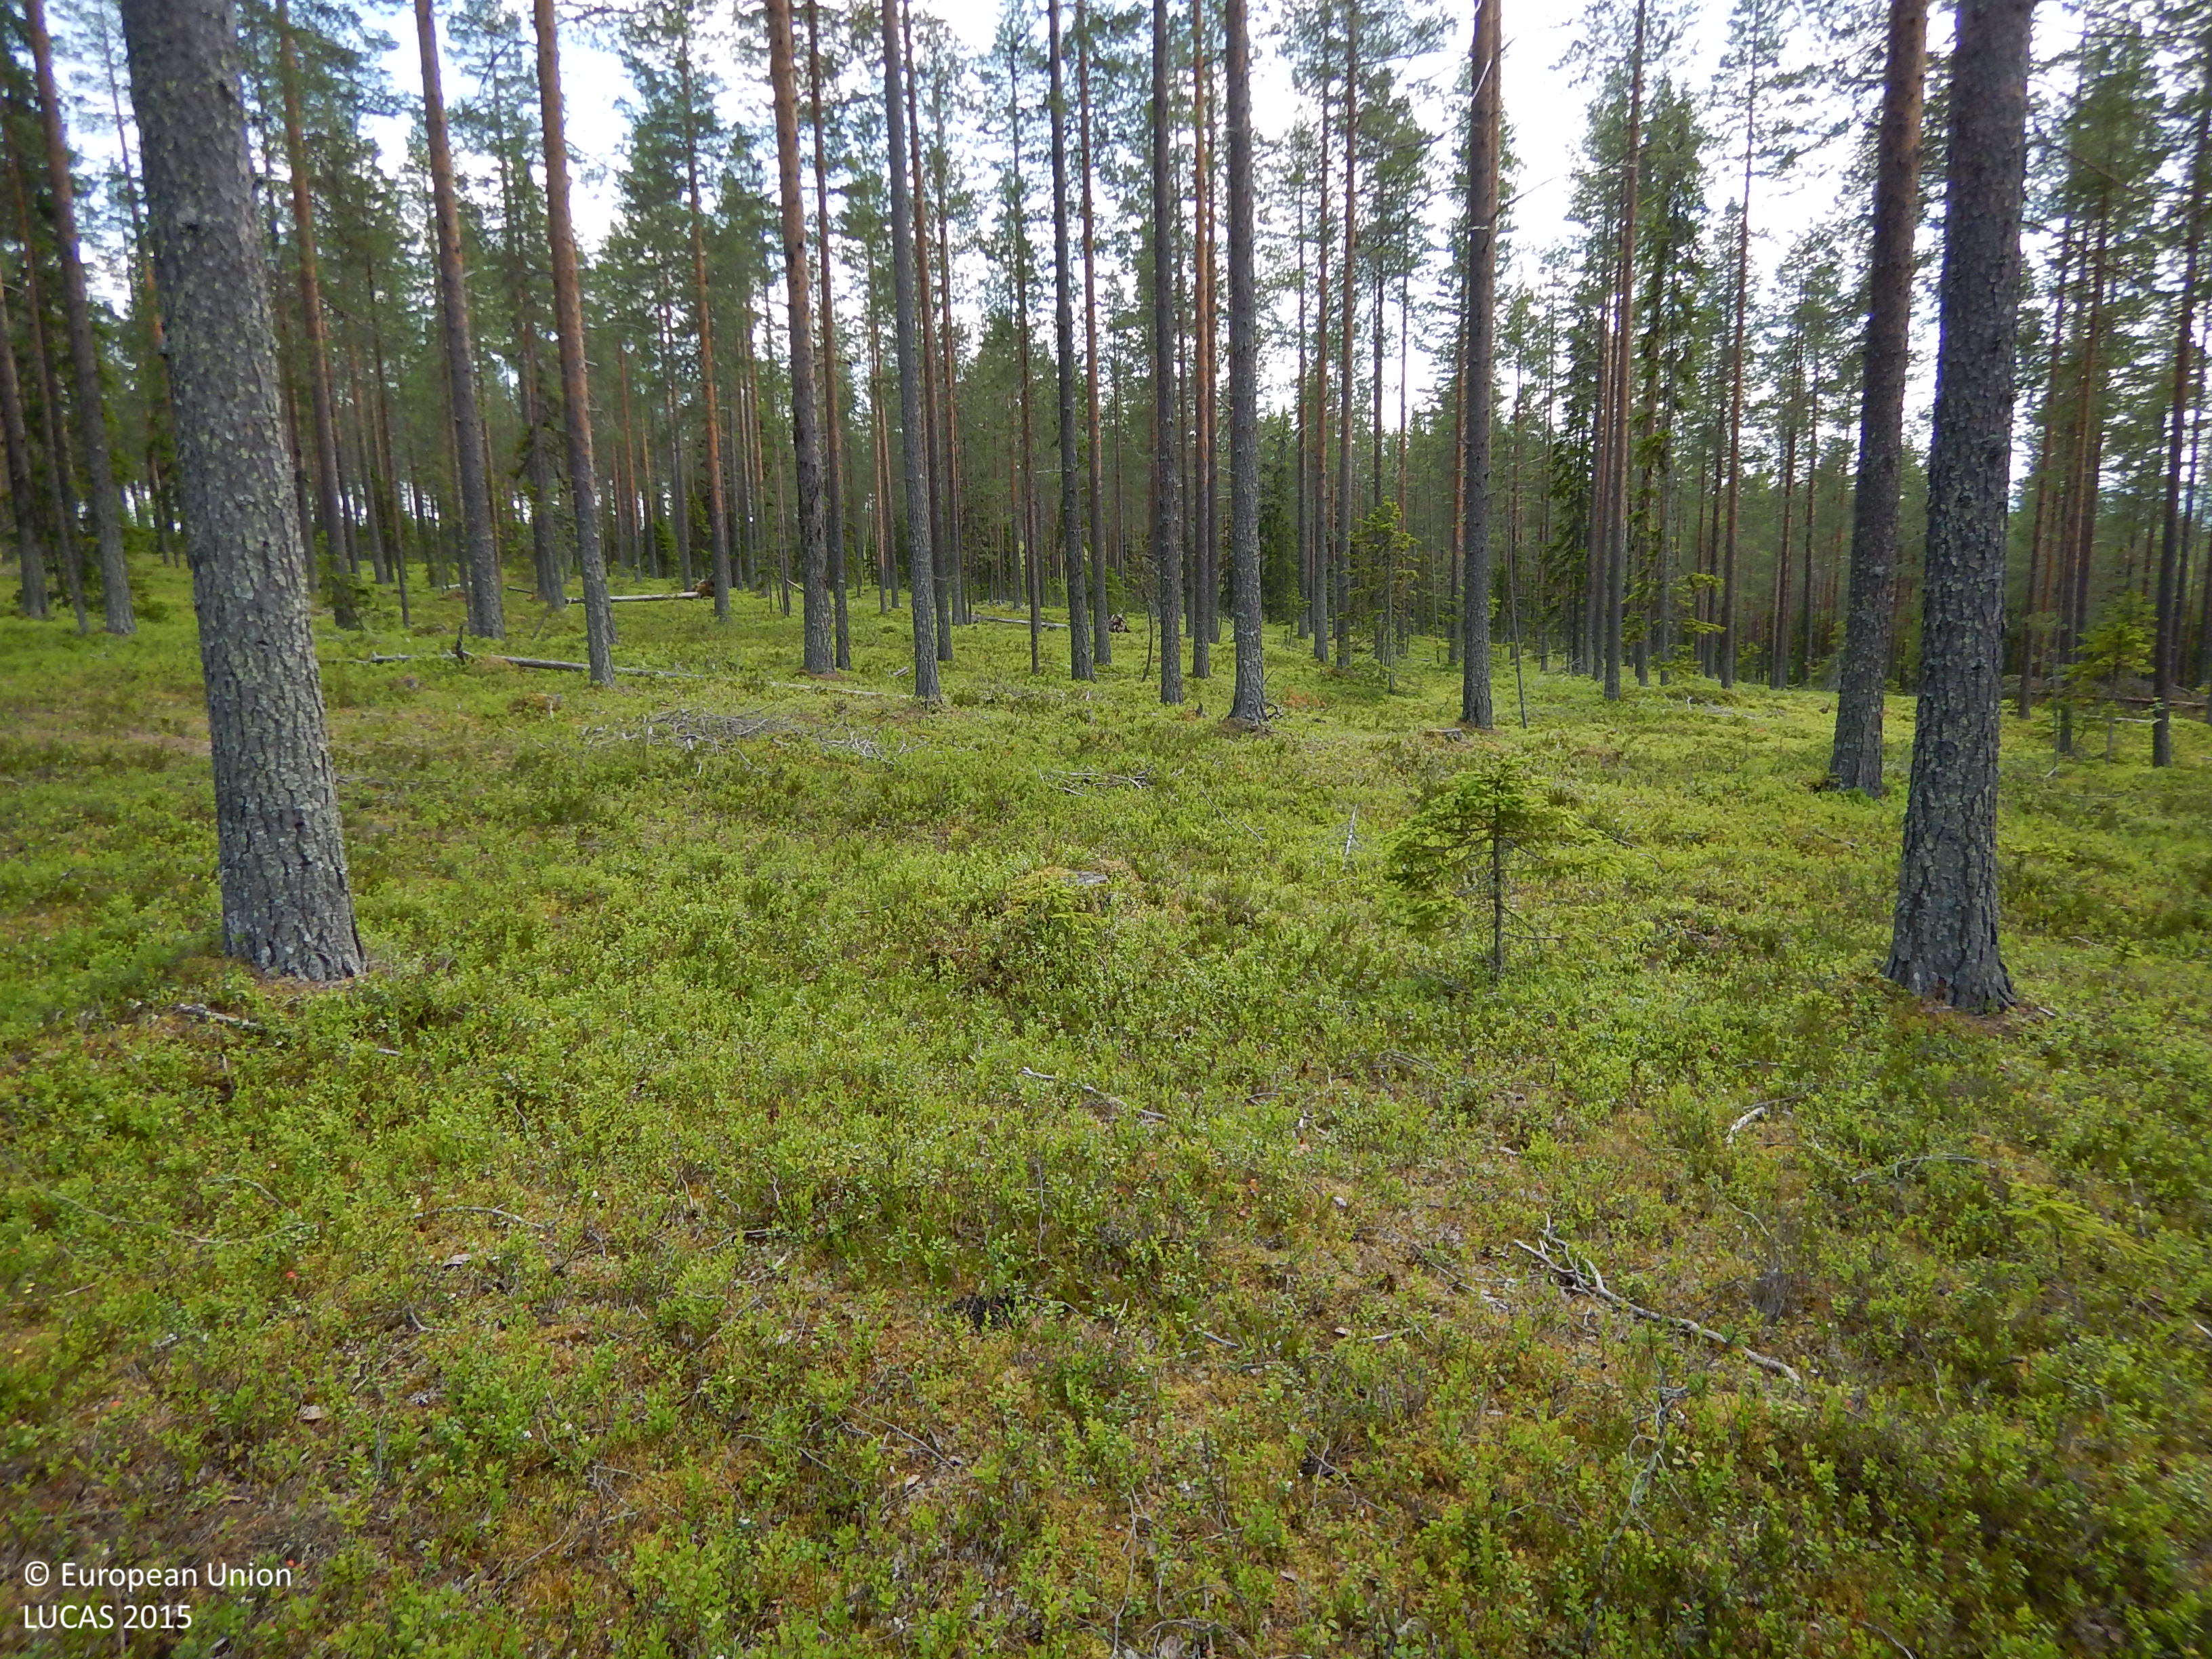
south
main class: Woodland
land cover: Pine dominated coniferous woodland
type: boreal forest
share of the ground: 50 - 75 %
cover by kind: coniferous forest trees 50 %, lichens and mosses 20 %, shrubs 15 %, herbaceous plants 15 %
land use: Forestry
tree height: > 5 m
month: July
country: SE
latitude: 65.0346
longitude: 19.9275
